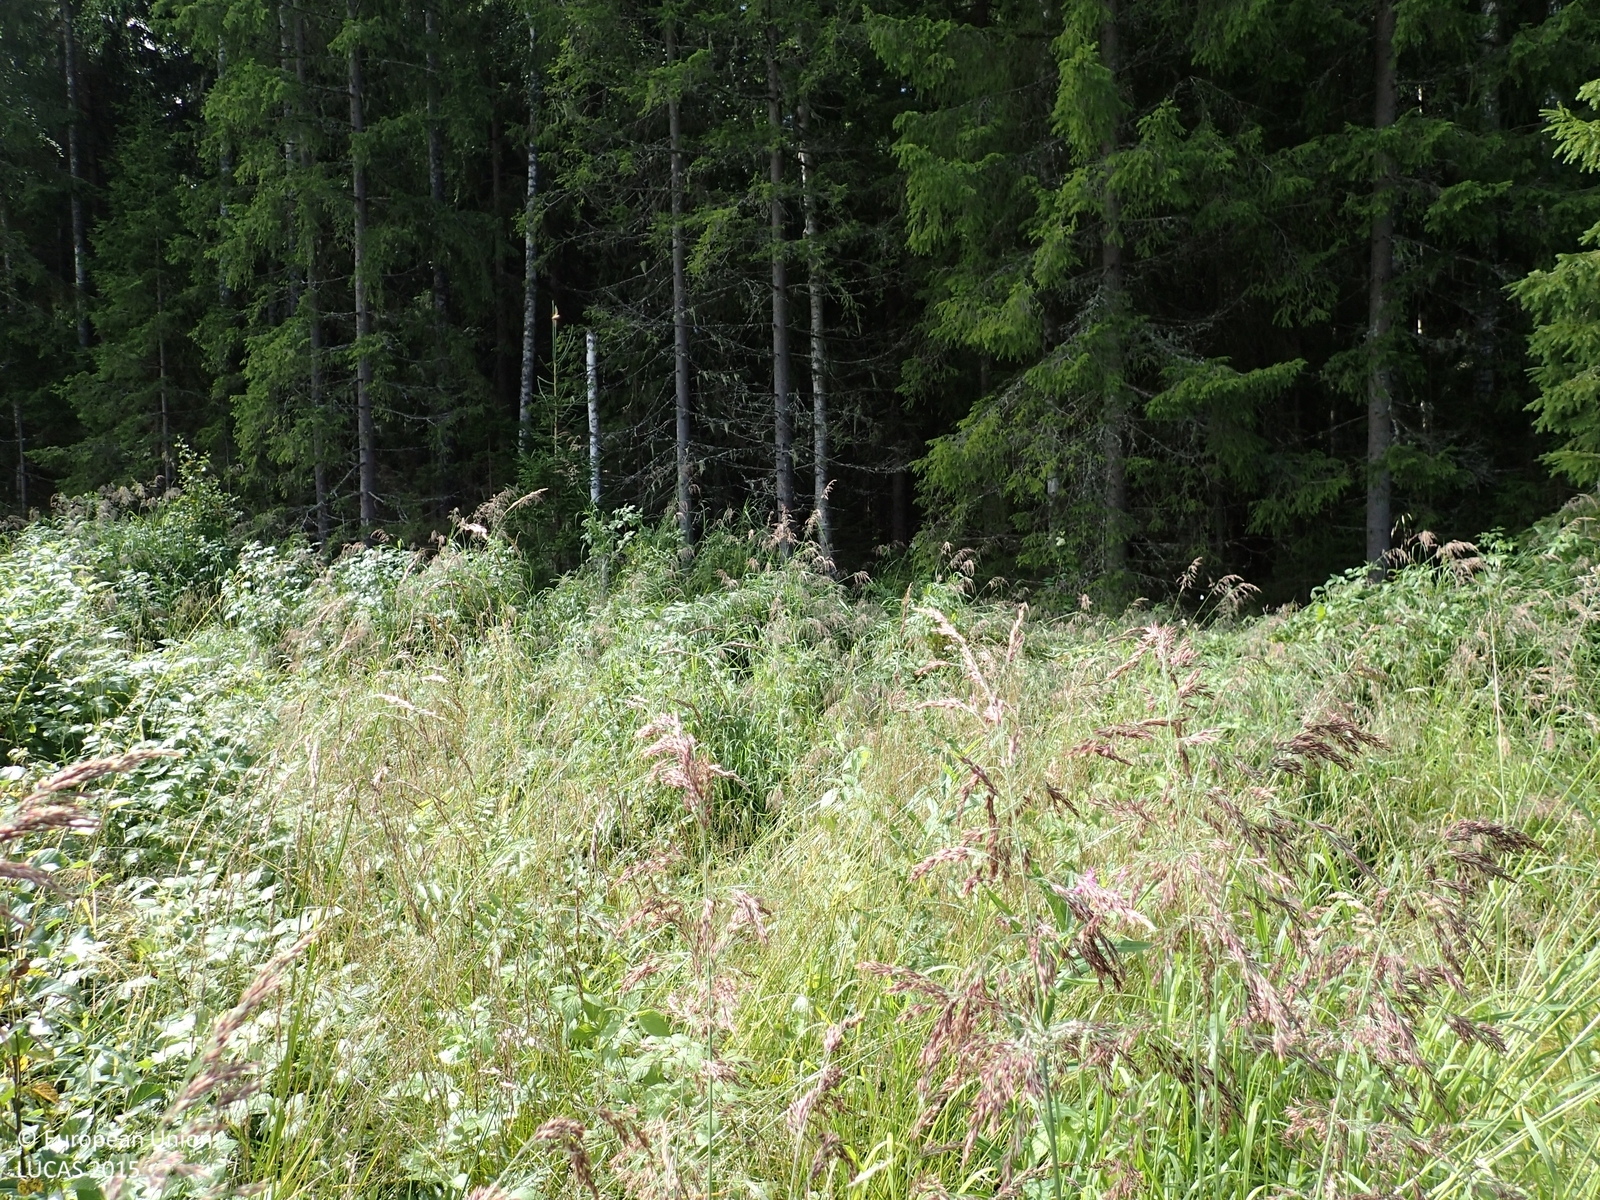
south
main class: Grassland
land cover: Grassland with sparse tree/shrub cover
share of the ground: > 75 %
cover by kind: herbaceous plants 95 %, broadleaved forest trees 5 %
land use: Forestry
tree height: < 5 m
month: July
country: FI
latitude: 62.9341
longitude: 22.6819
